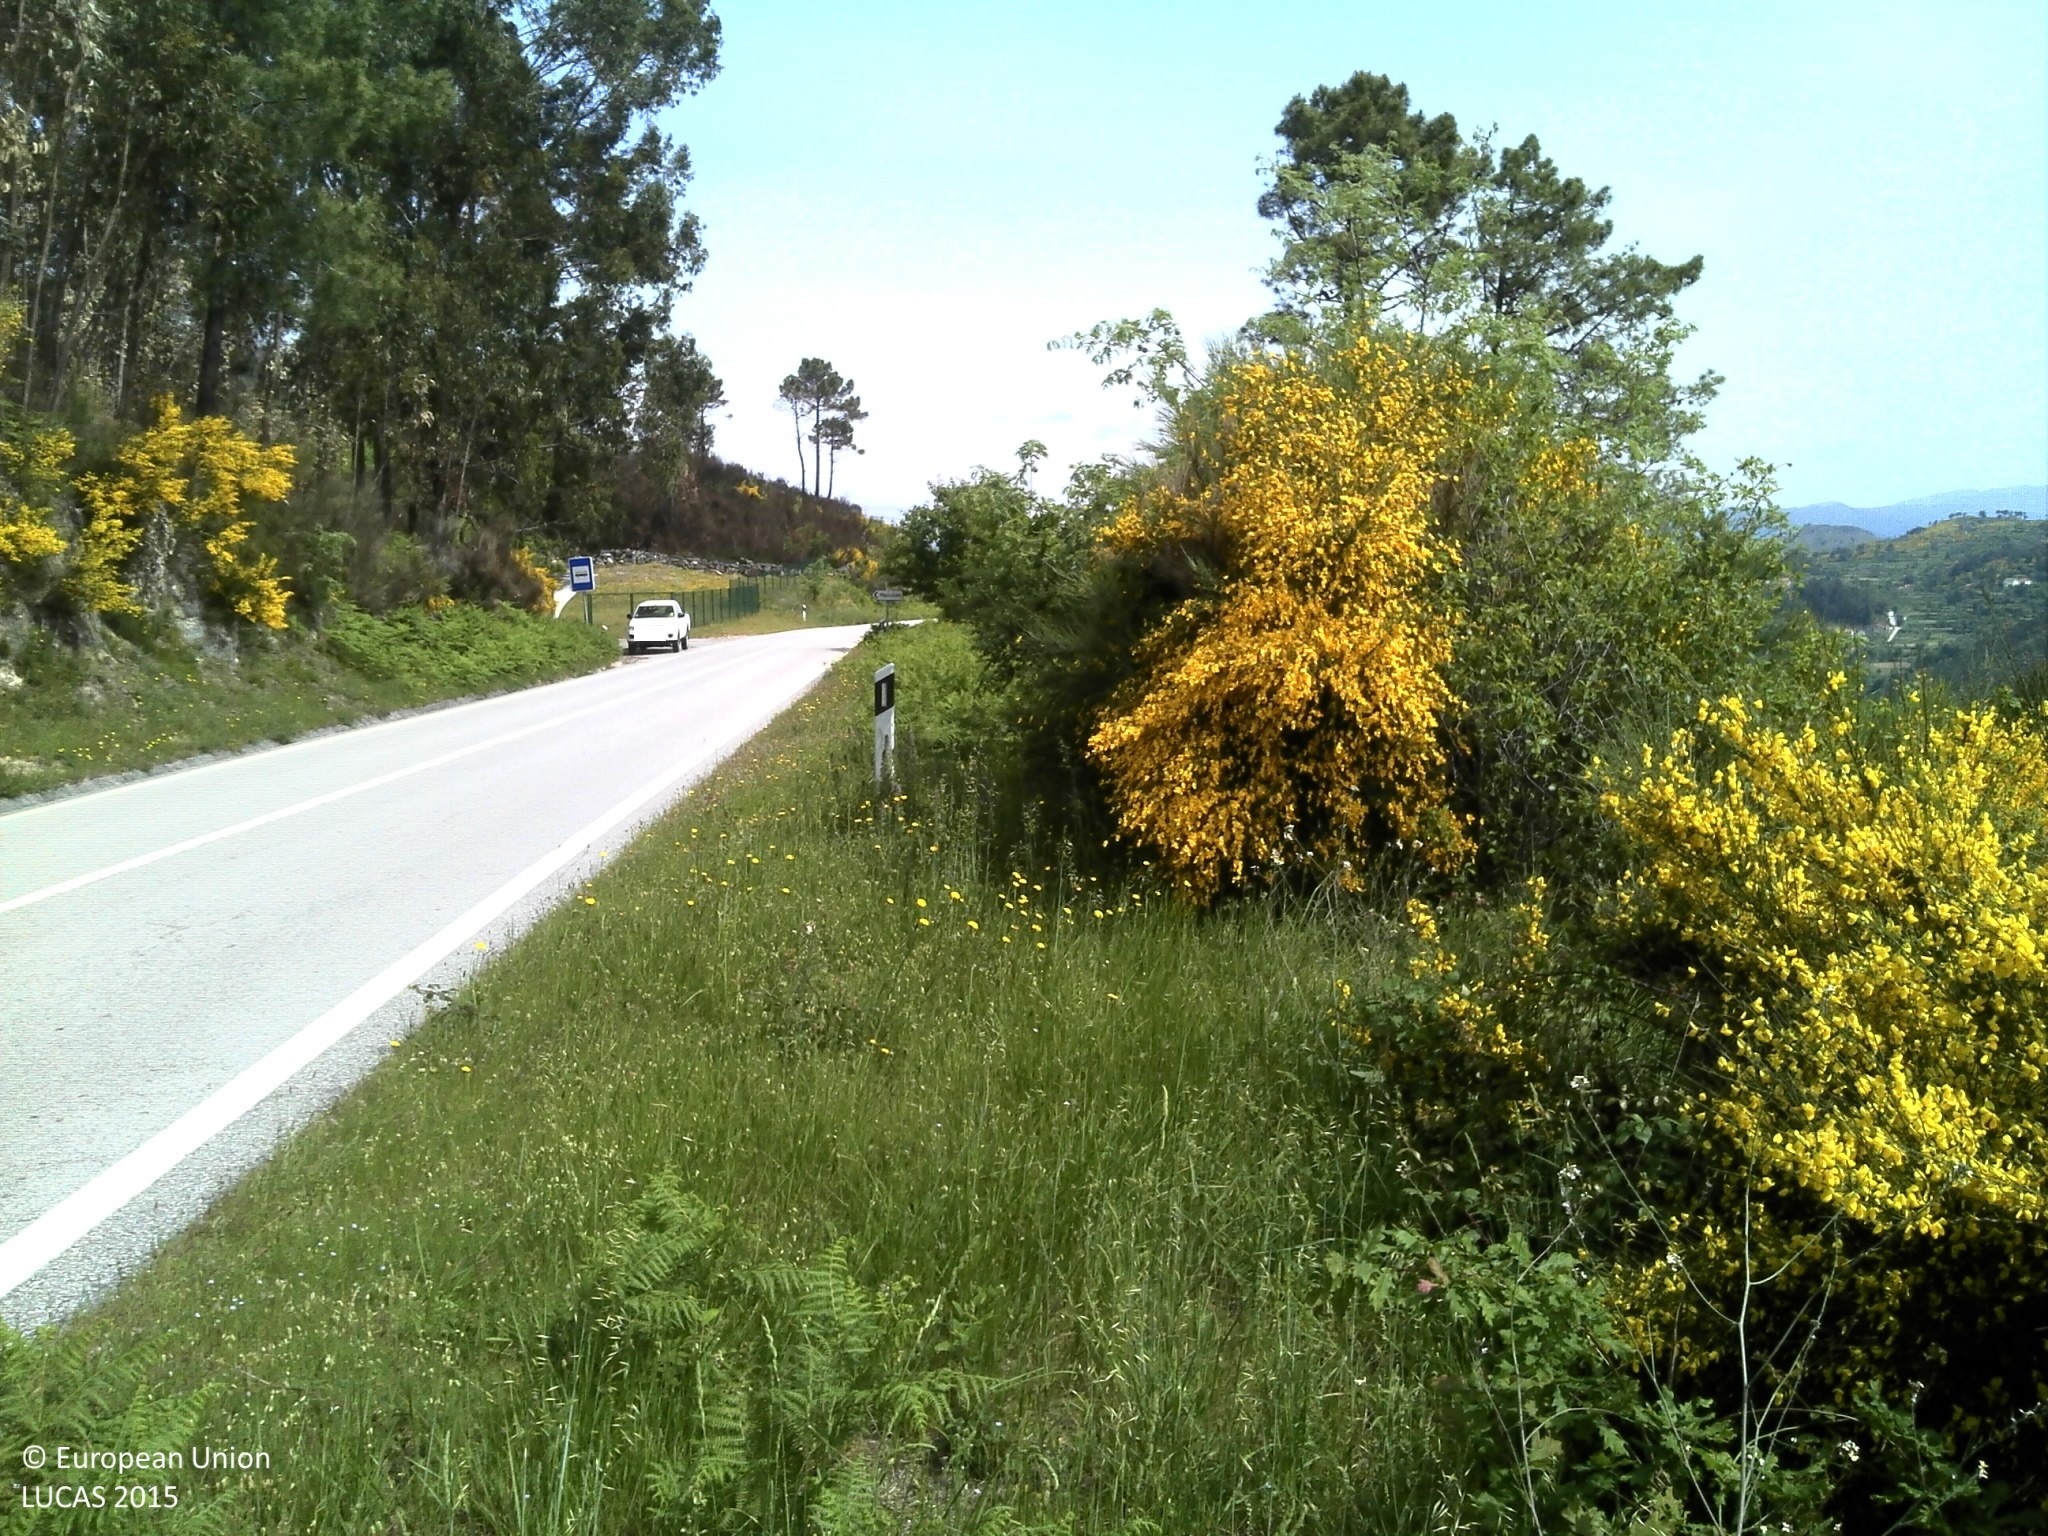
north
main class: Shrubland
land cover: Shrubland without tree cover
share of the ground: 50 - 75 %
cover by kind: shrubs 75 %, herbaceous plants 10 %, consolidated bare surface 10 %, unconsolidated bare surface 5 %
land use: Abandoned areas
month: May
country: PT
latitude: 41.0331
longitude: -8.0597
